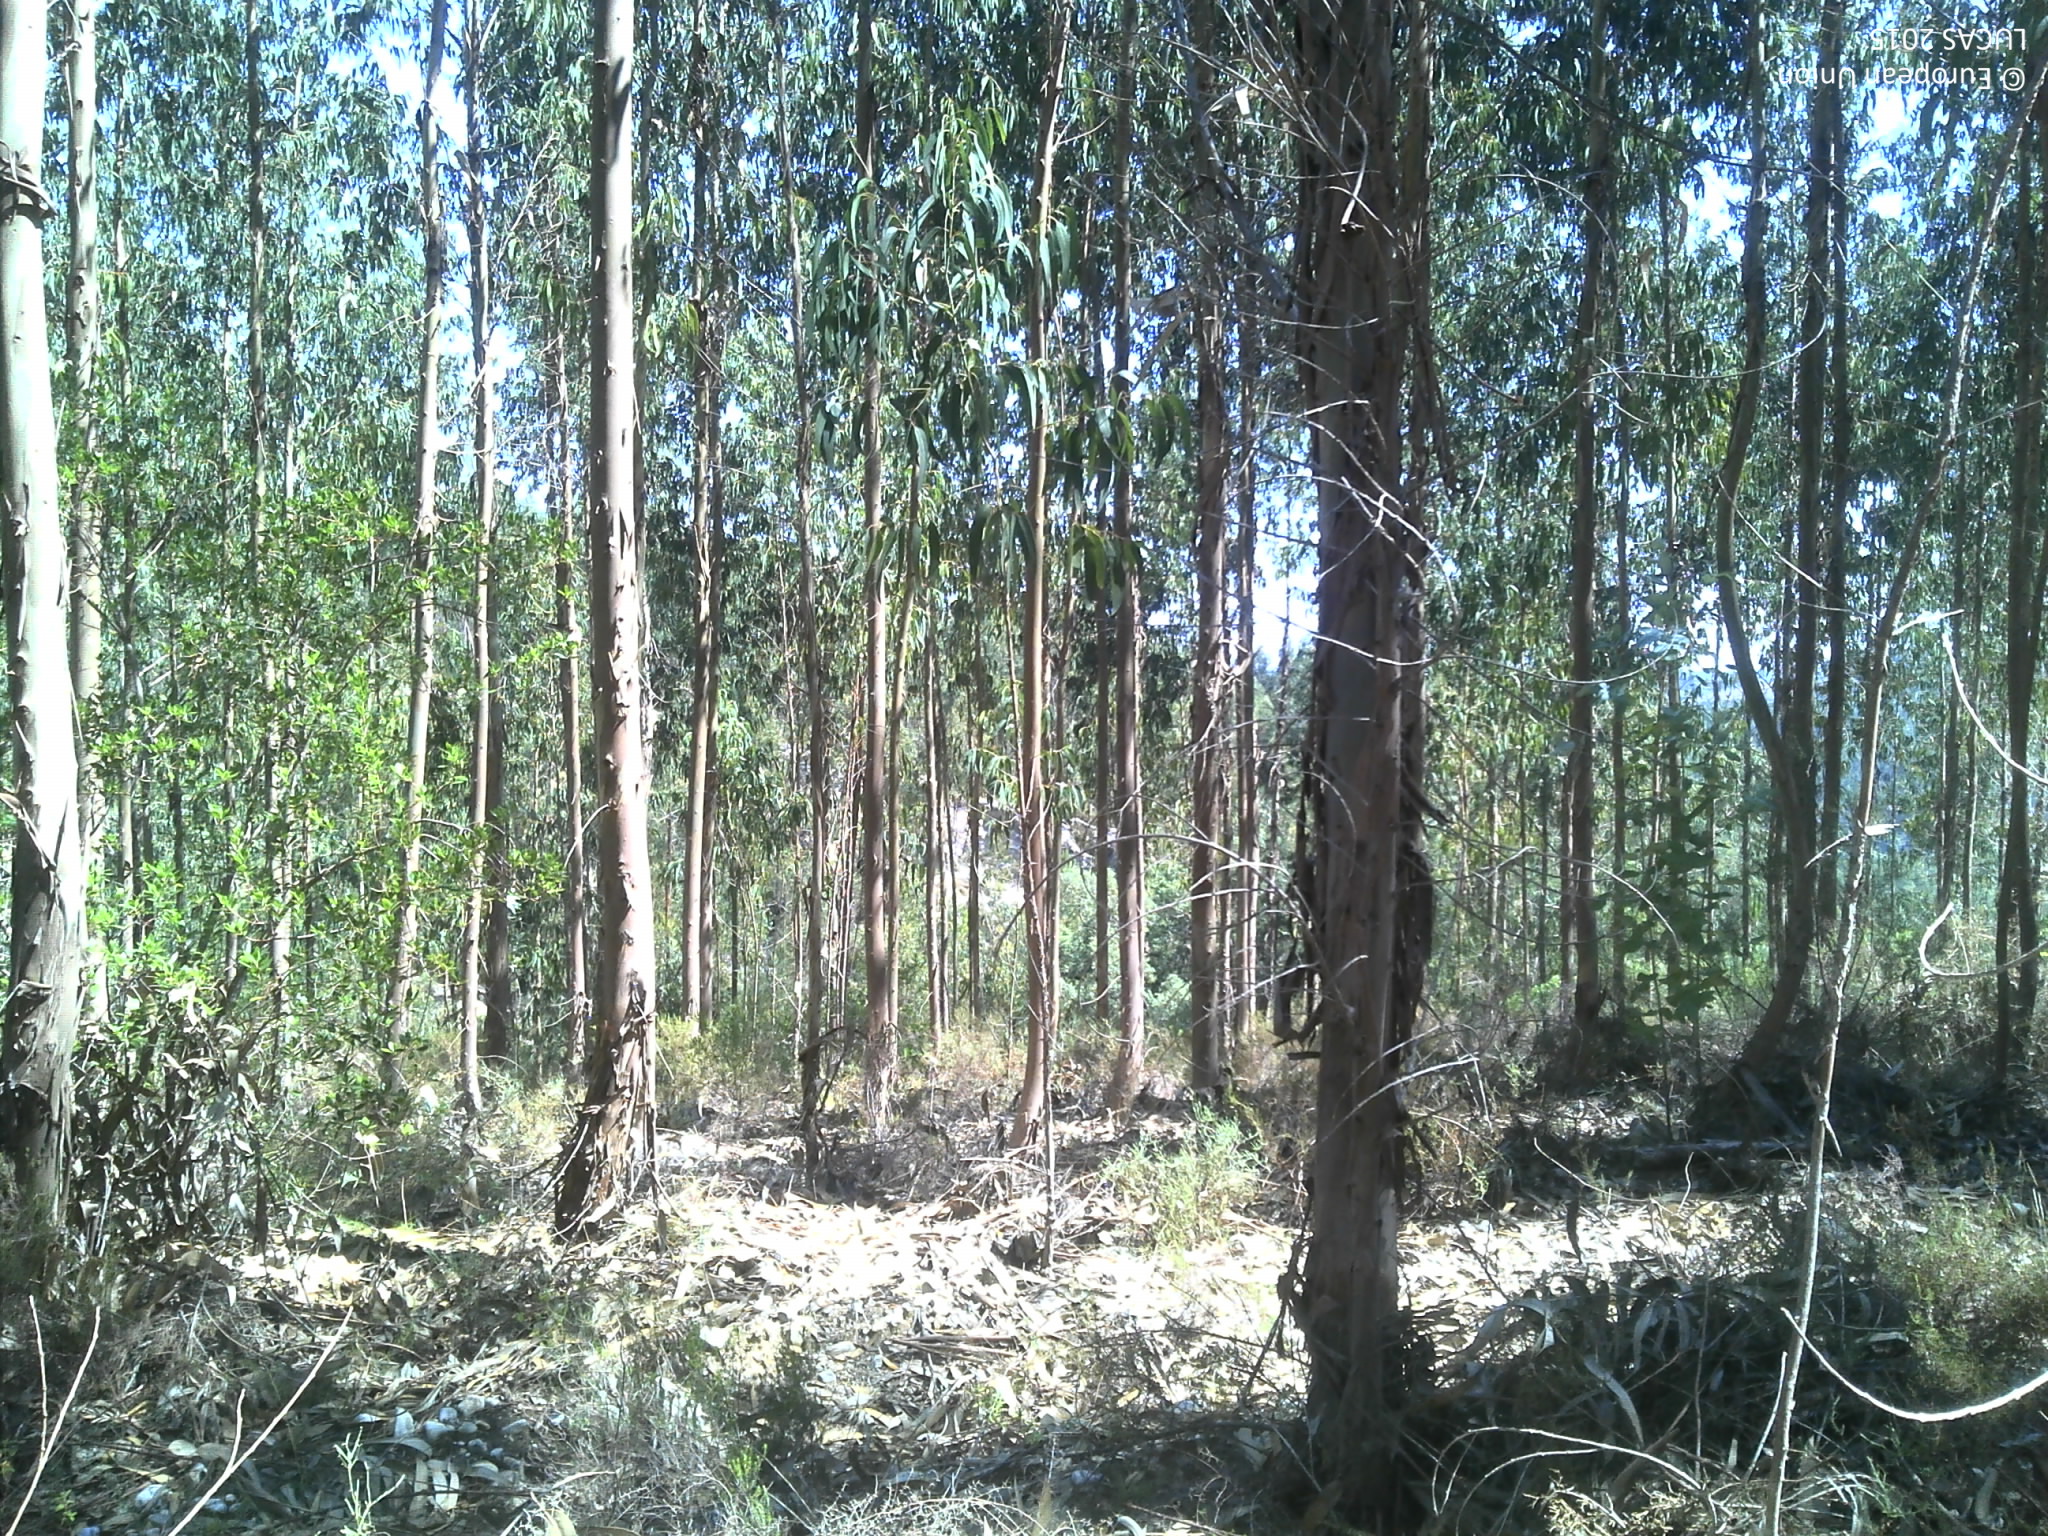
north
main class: Woodland
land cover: Broadleaved woodland
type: exotic forest
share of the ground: 50 - 75 %
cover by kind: broadleaved forest trees 75 %, unconsolidated bare surface 15 %, shrubs 10 %
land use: Forestry
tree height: > 5 m
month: June
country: PT
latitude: 39.3141
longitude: -8.3553
